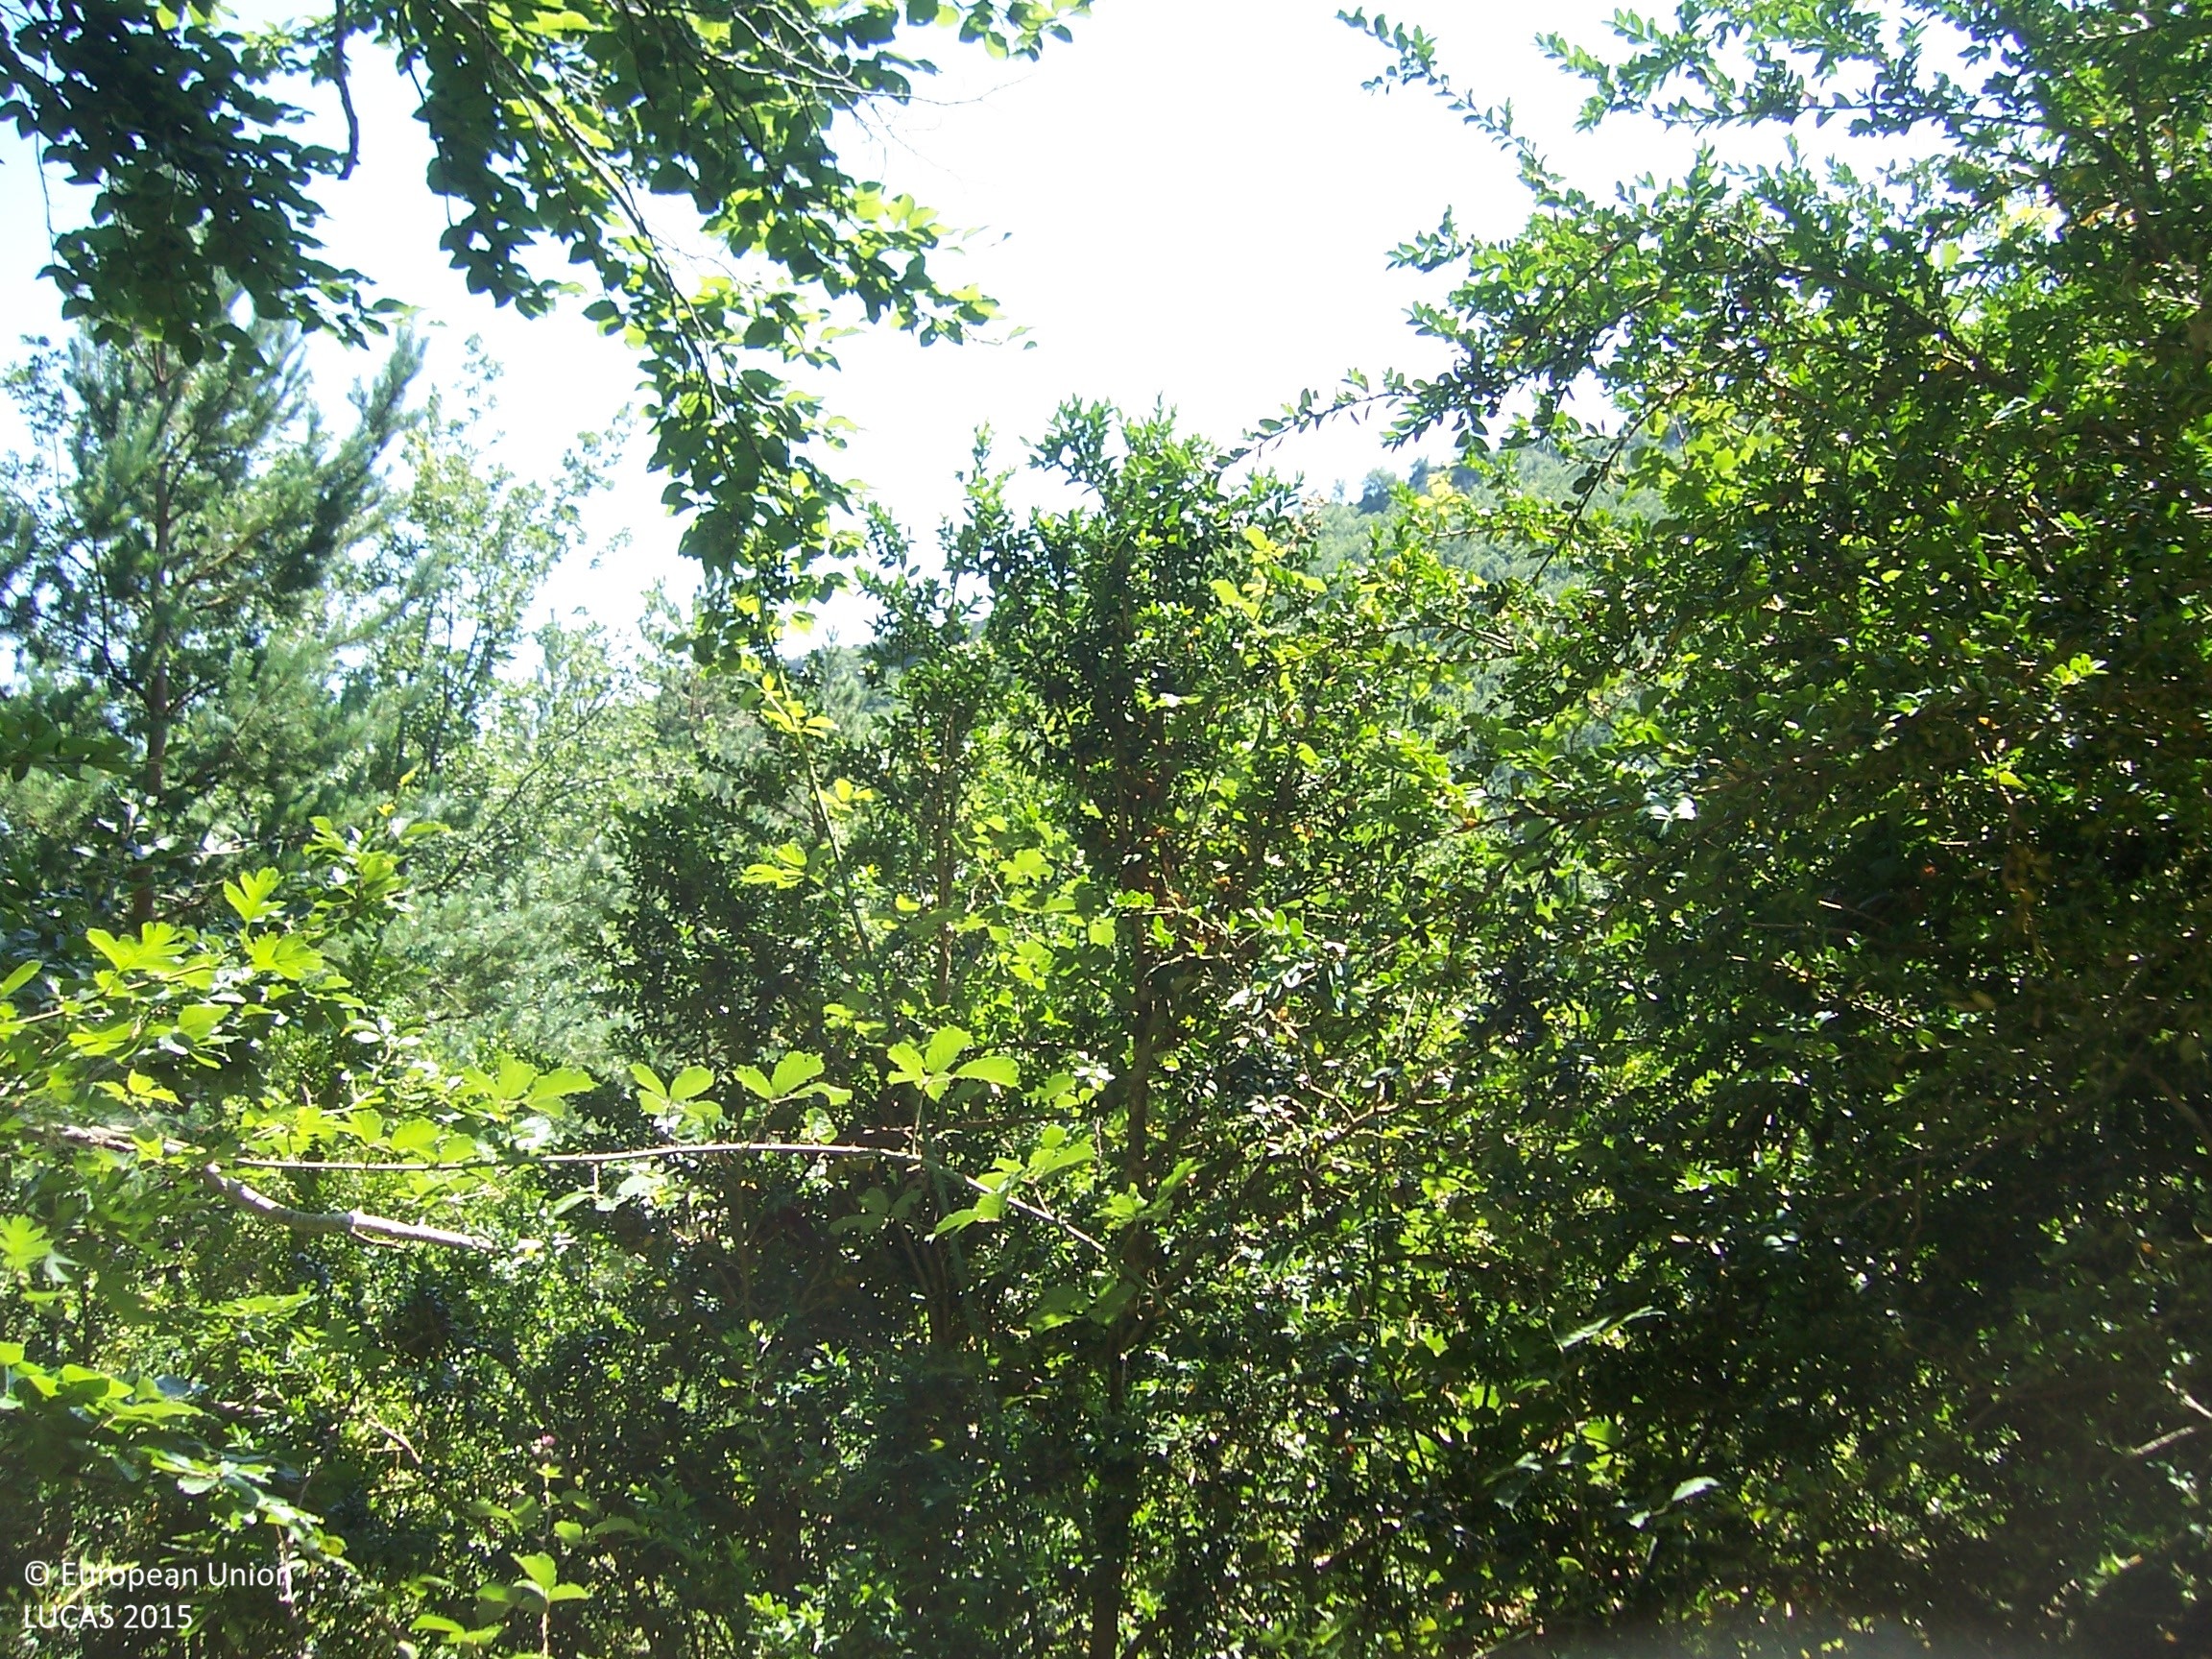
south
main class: Woodland
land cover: Broadleaved woodland
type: beech forest
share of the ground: > 75 %
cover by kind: broadleaved forest trees 75 %, coniferous forest trees 20 %, shrubs 5 %
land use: Forestry
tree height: > 5 m
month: July
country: ES
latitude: 42.8620
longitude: -1.2592
